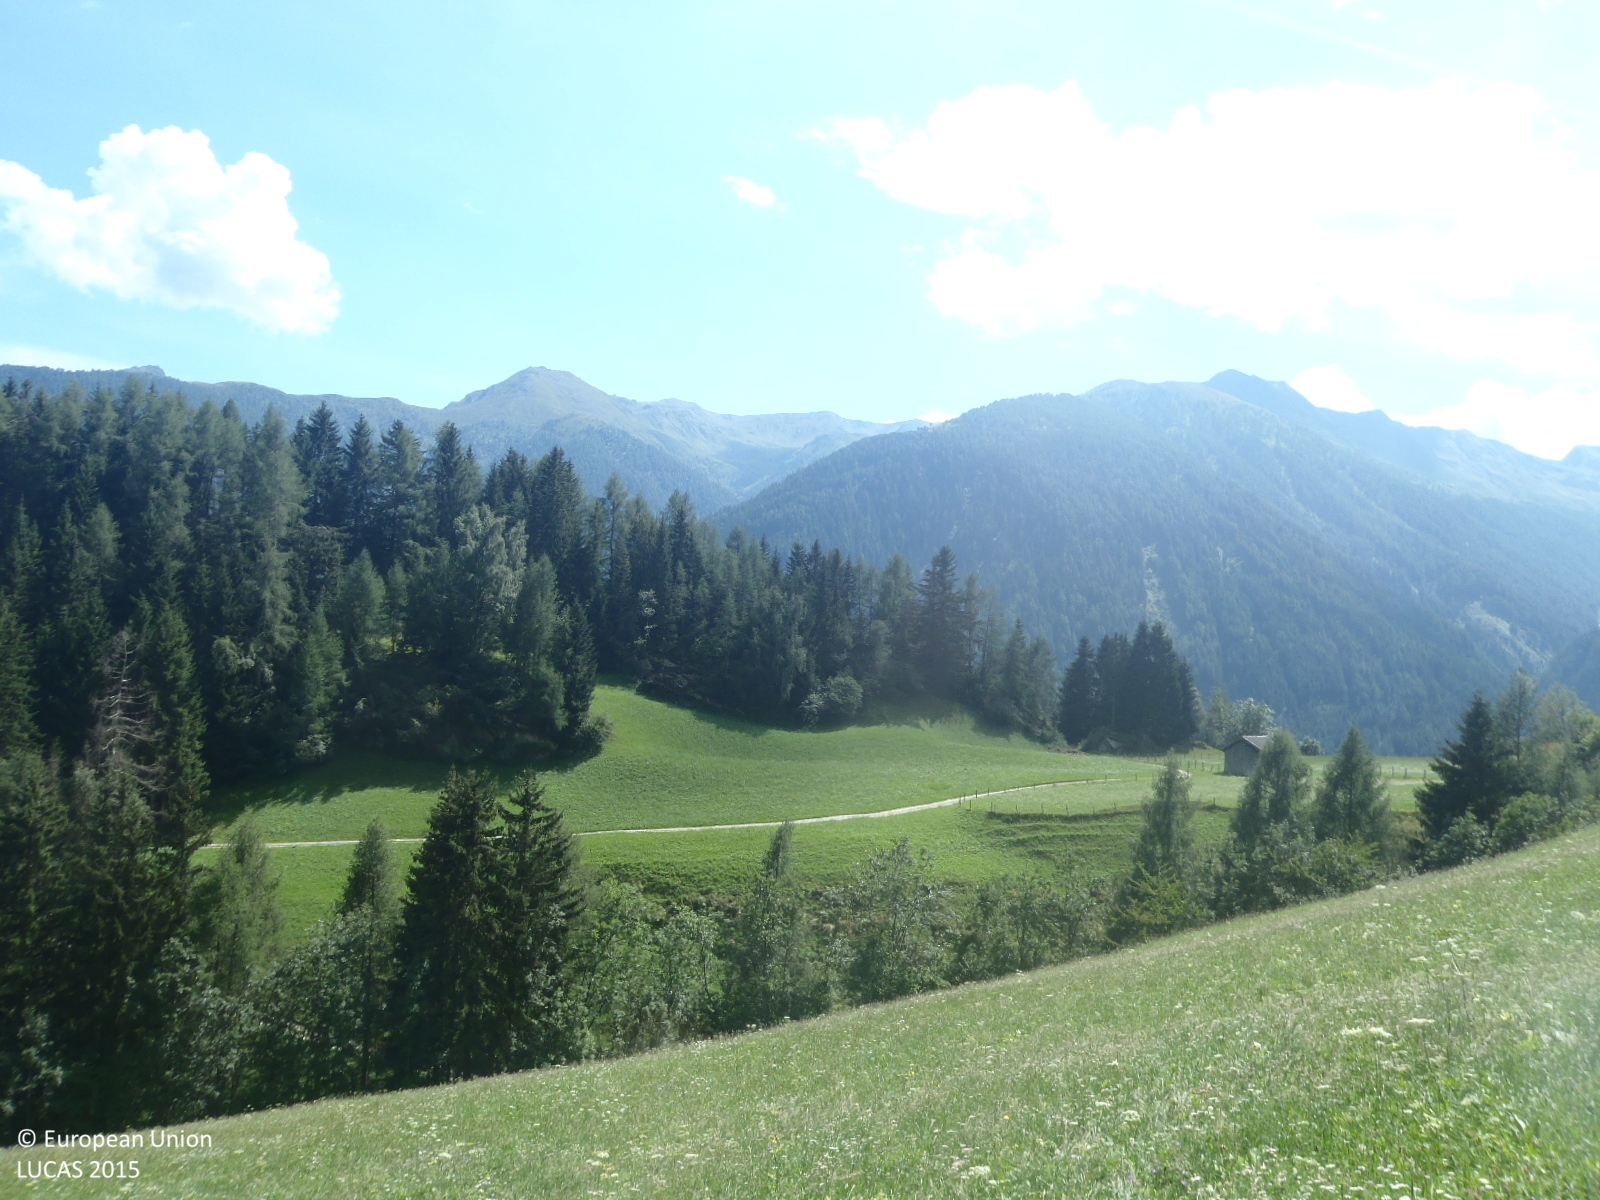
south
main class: Grassland
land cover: Grassland without tree/shrub cover
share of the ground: > 75 %
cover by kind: herbaceous plants 100 %
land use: Agriculture (excluding fallow land and kitchen gardens)
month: August
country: AT
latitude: 47.0082
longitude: 12.4312
